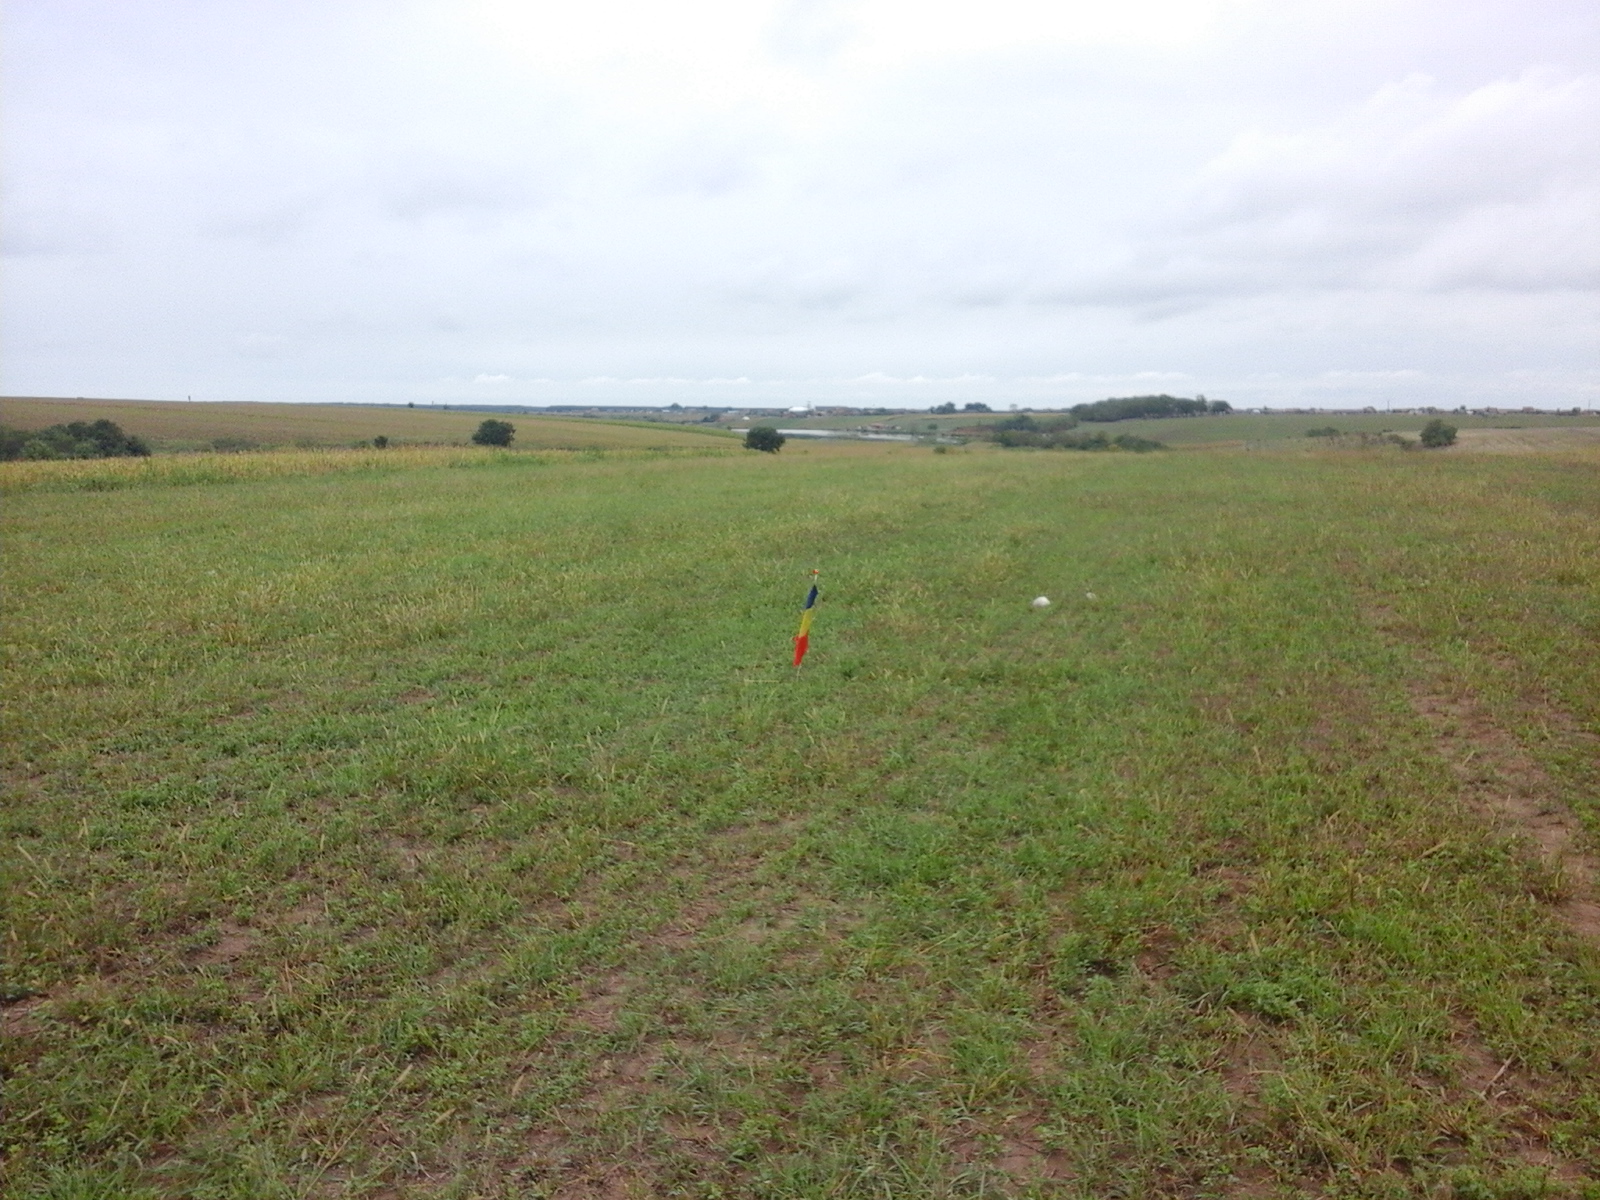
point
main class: Grassland
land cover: Grassland without tree/shrub cover
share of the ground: > 75 %
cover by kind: herbaceous plants 100 %
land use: Agriculture (excluding fallow land and kitchen gardens)
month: September
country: RO
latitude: 46.6790
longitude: 21.9543
